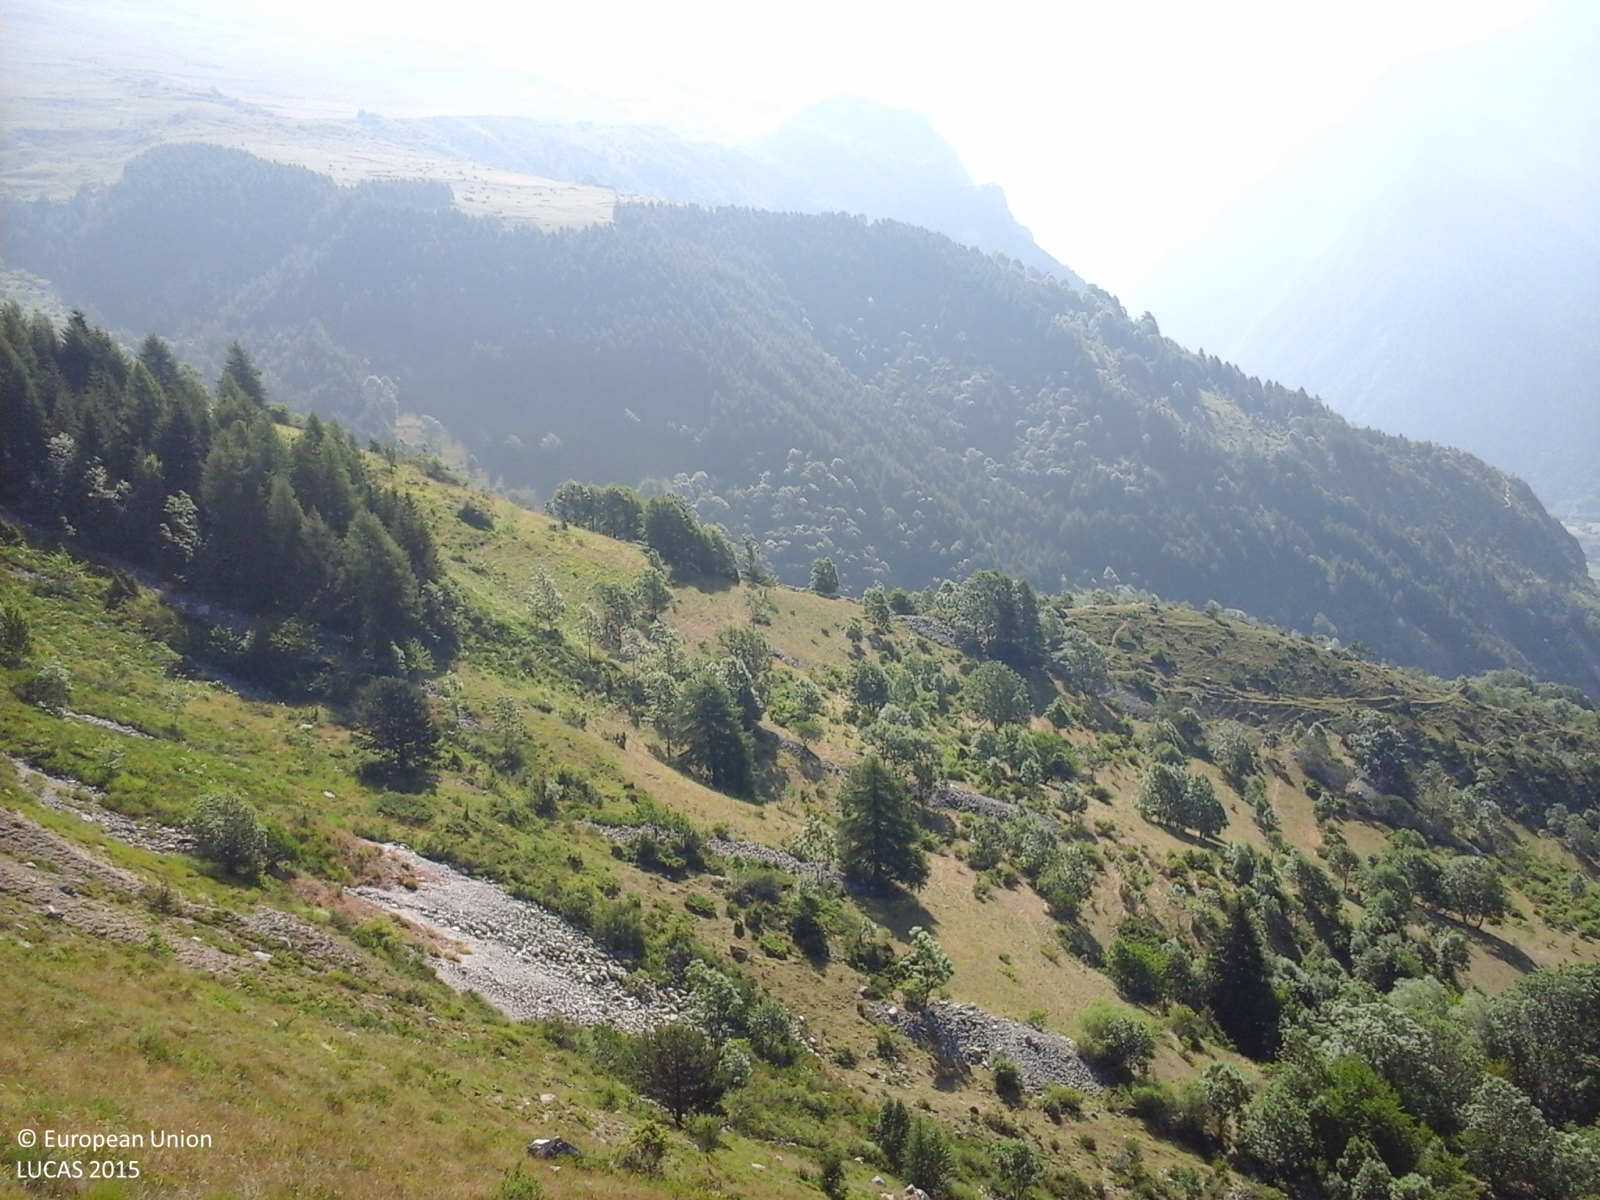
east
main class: Grassland
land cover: Grassland without tree/shrub cover
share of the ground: > 75 %
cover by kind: herbaceous plants 90 %, consolidated bare surface 10 %
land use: Agriculture (excluding fallow land and kitchen gardens)
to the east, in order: Grassland without tree/shrub cover; Rocks and stones; Grassland with sparse tree/shrub cover; Grassland without tree/shrub cover
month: July
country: IT
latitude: 44.4870
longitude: 6.9755
